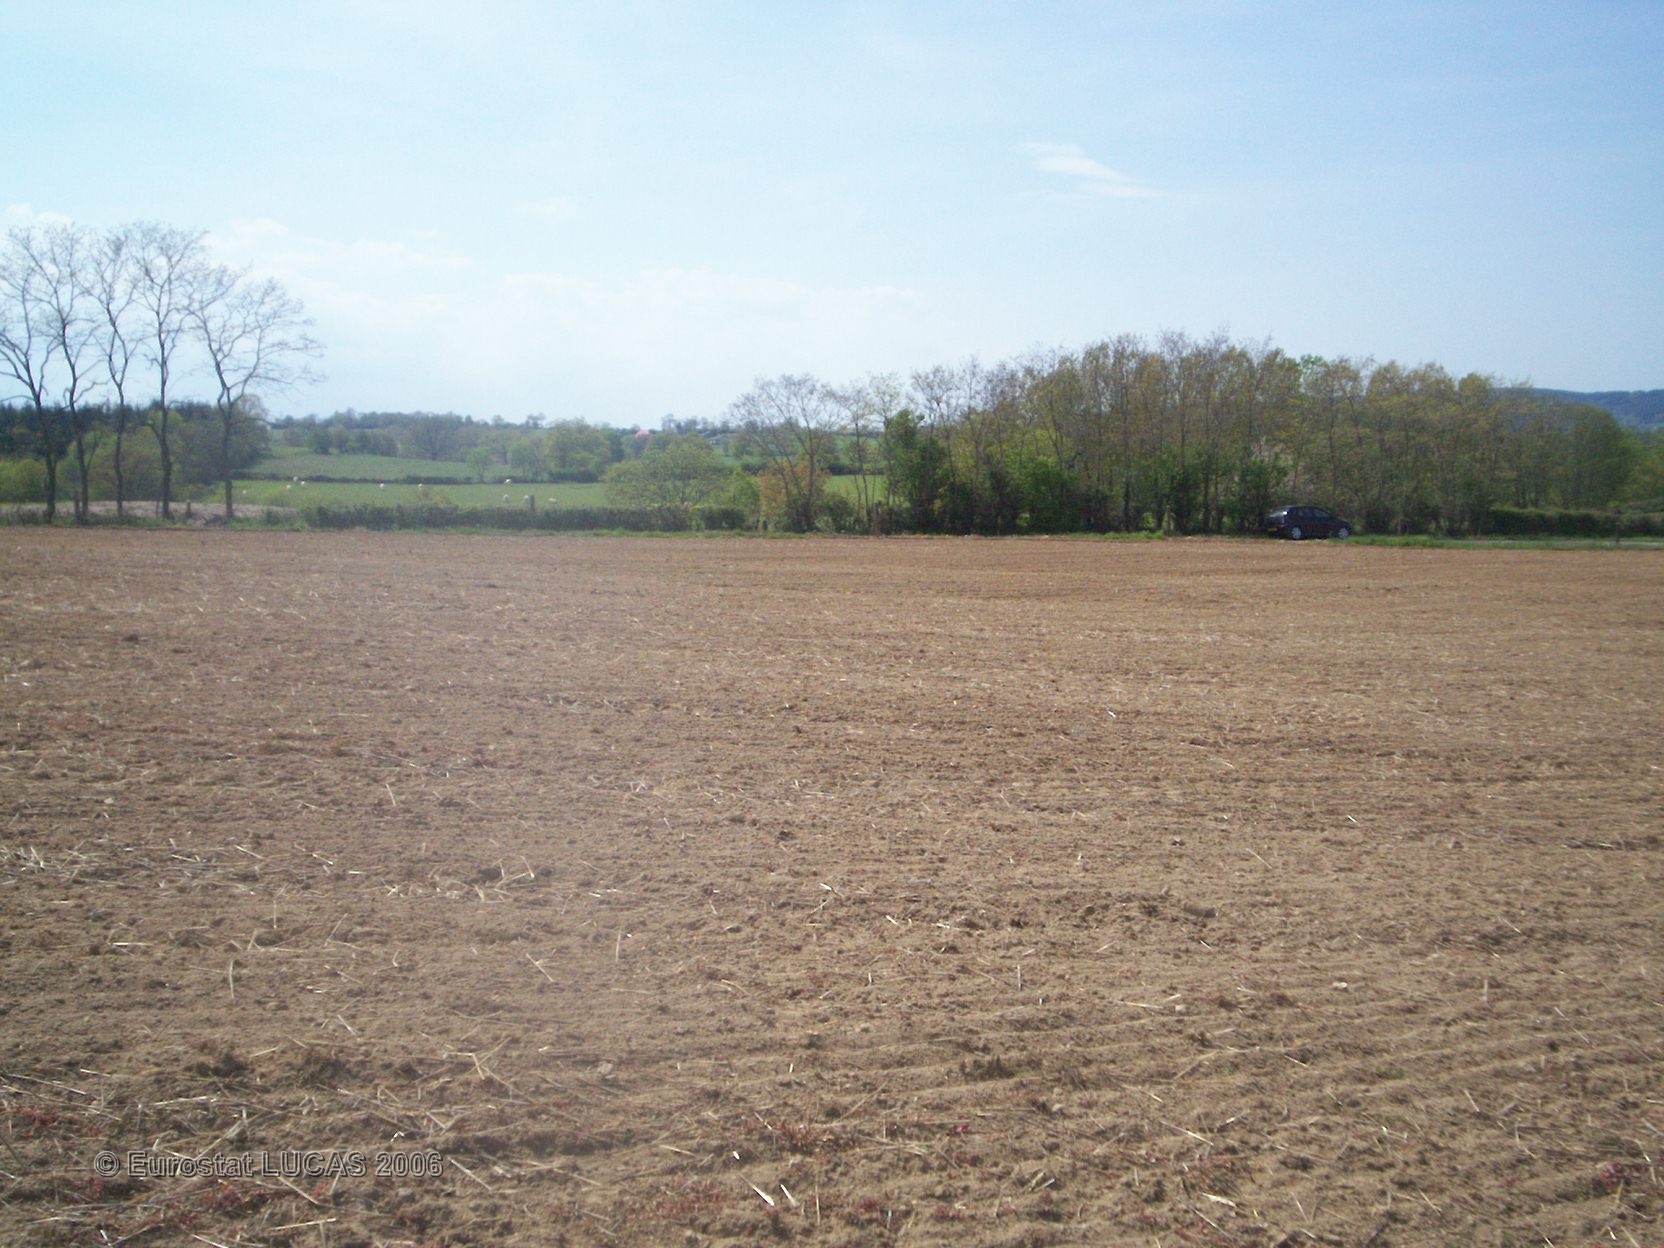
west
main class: Cropland
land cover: Barley
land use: Agriculture (excluding fallow land and kitchen gardens)
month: May
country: FR
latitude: 46.4576
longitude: 3.1623
